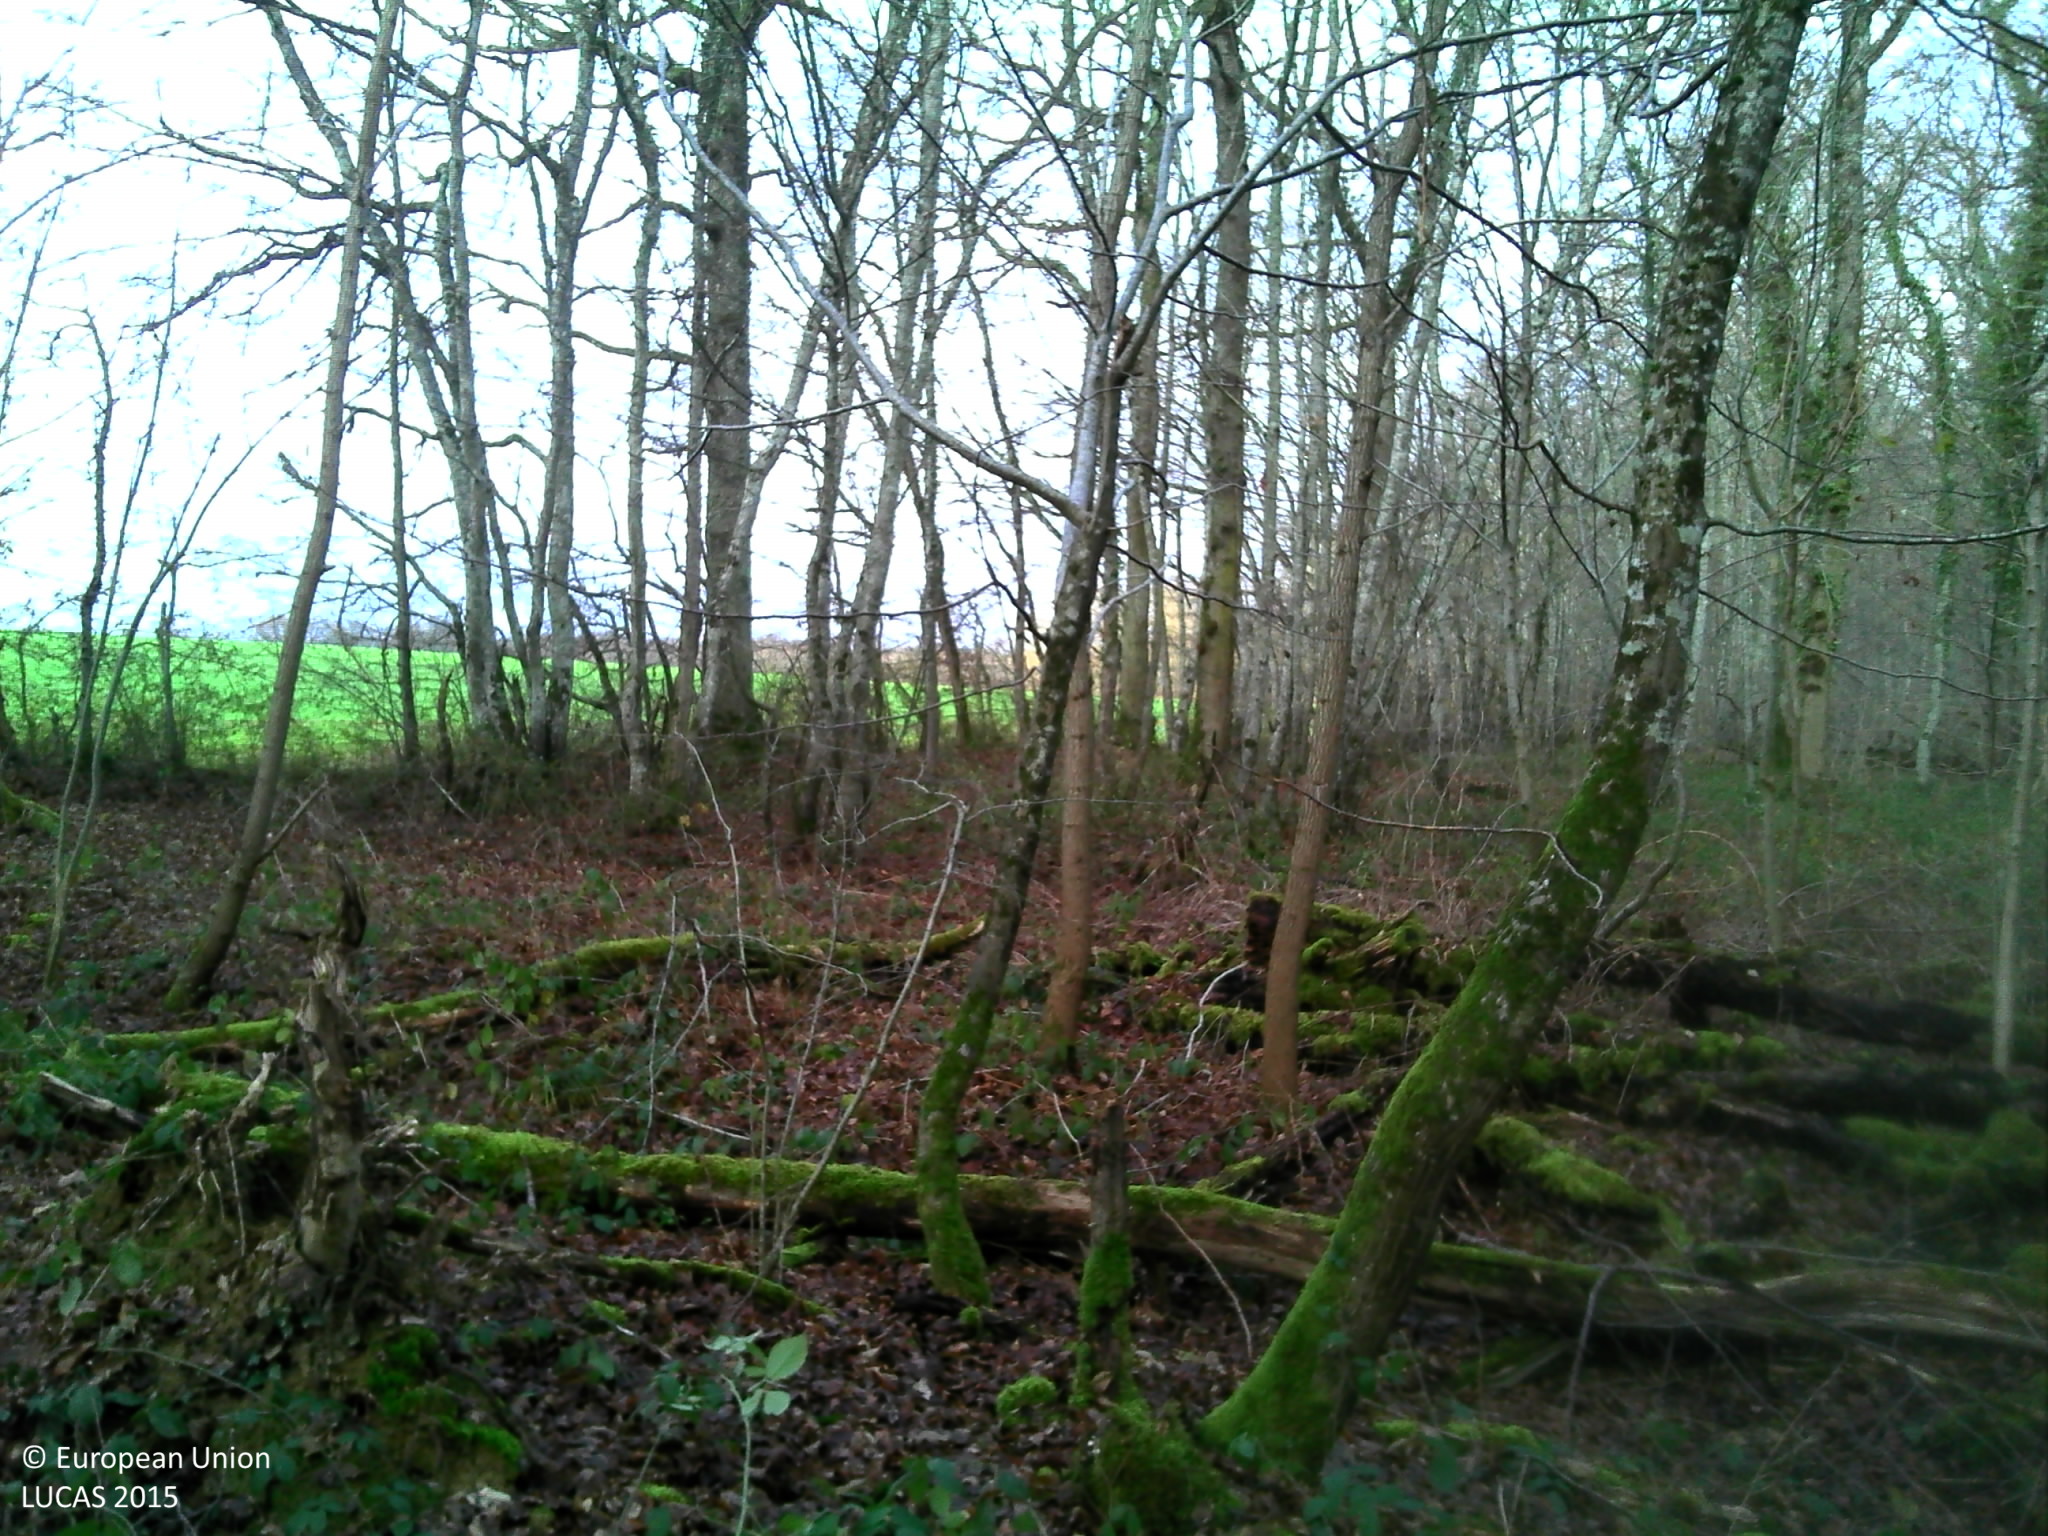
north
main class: Woodland
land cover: Broadleaved woodland
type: mesophytic deciduous forest
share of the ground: > 75 %
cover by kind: broadleaved forest trees 100 %
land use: Forestry
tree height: > 5 m
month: December
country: FR
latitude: 47.2621
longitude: 3.6140
